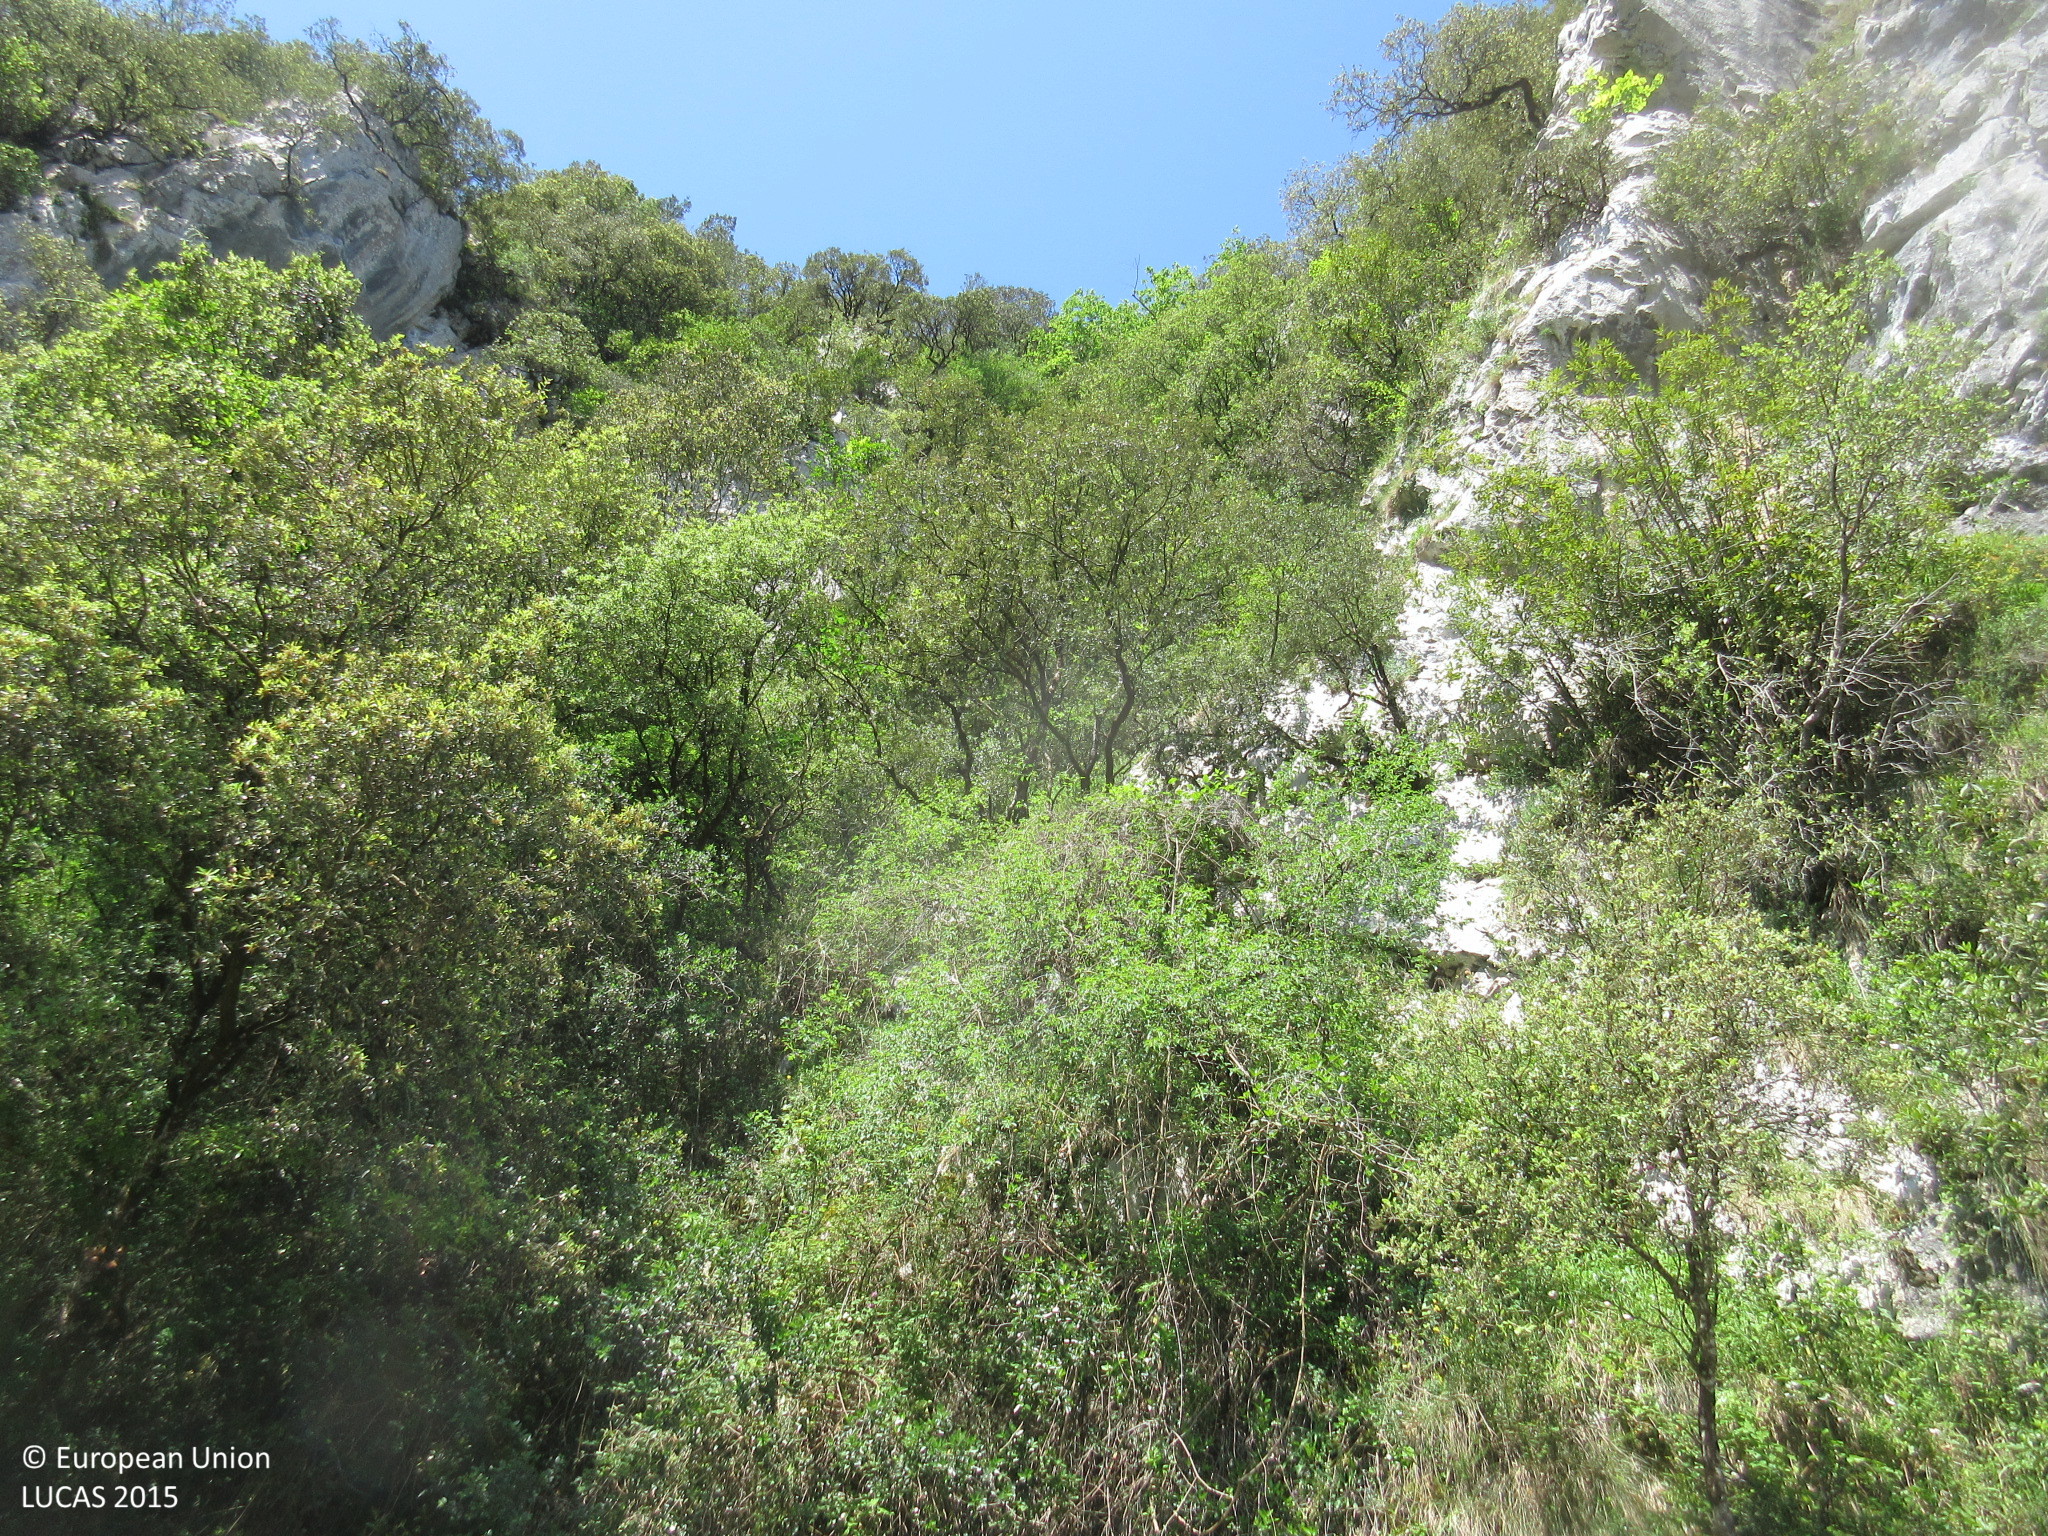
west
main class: Woodland
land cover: Broadleaved woodland
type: broadleaved evergreen forest
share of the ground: > 75 %
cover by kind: broadleaved forest trees 90 %, shrubs 5 %, herbaceous plants 5 %
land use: Semi-natural and natural areas not in use
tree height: > 5 m
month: May
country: ES
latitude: 43.2726
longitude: -4.4874
